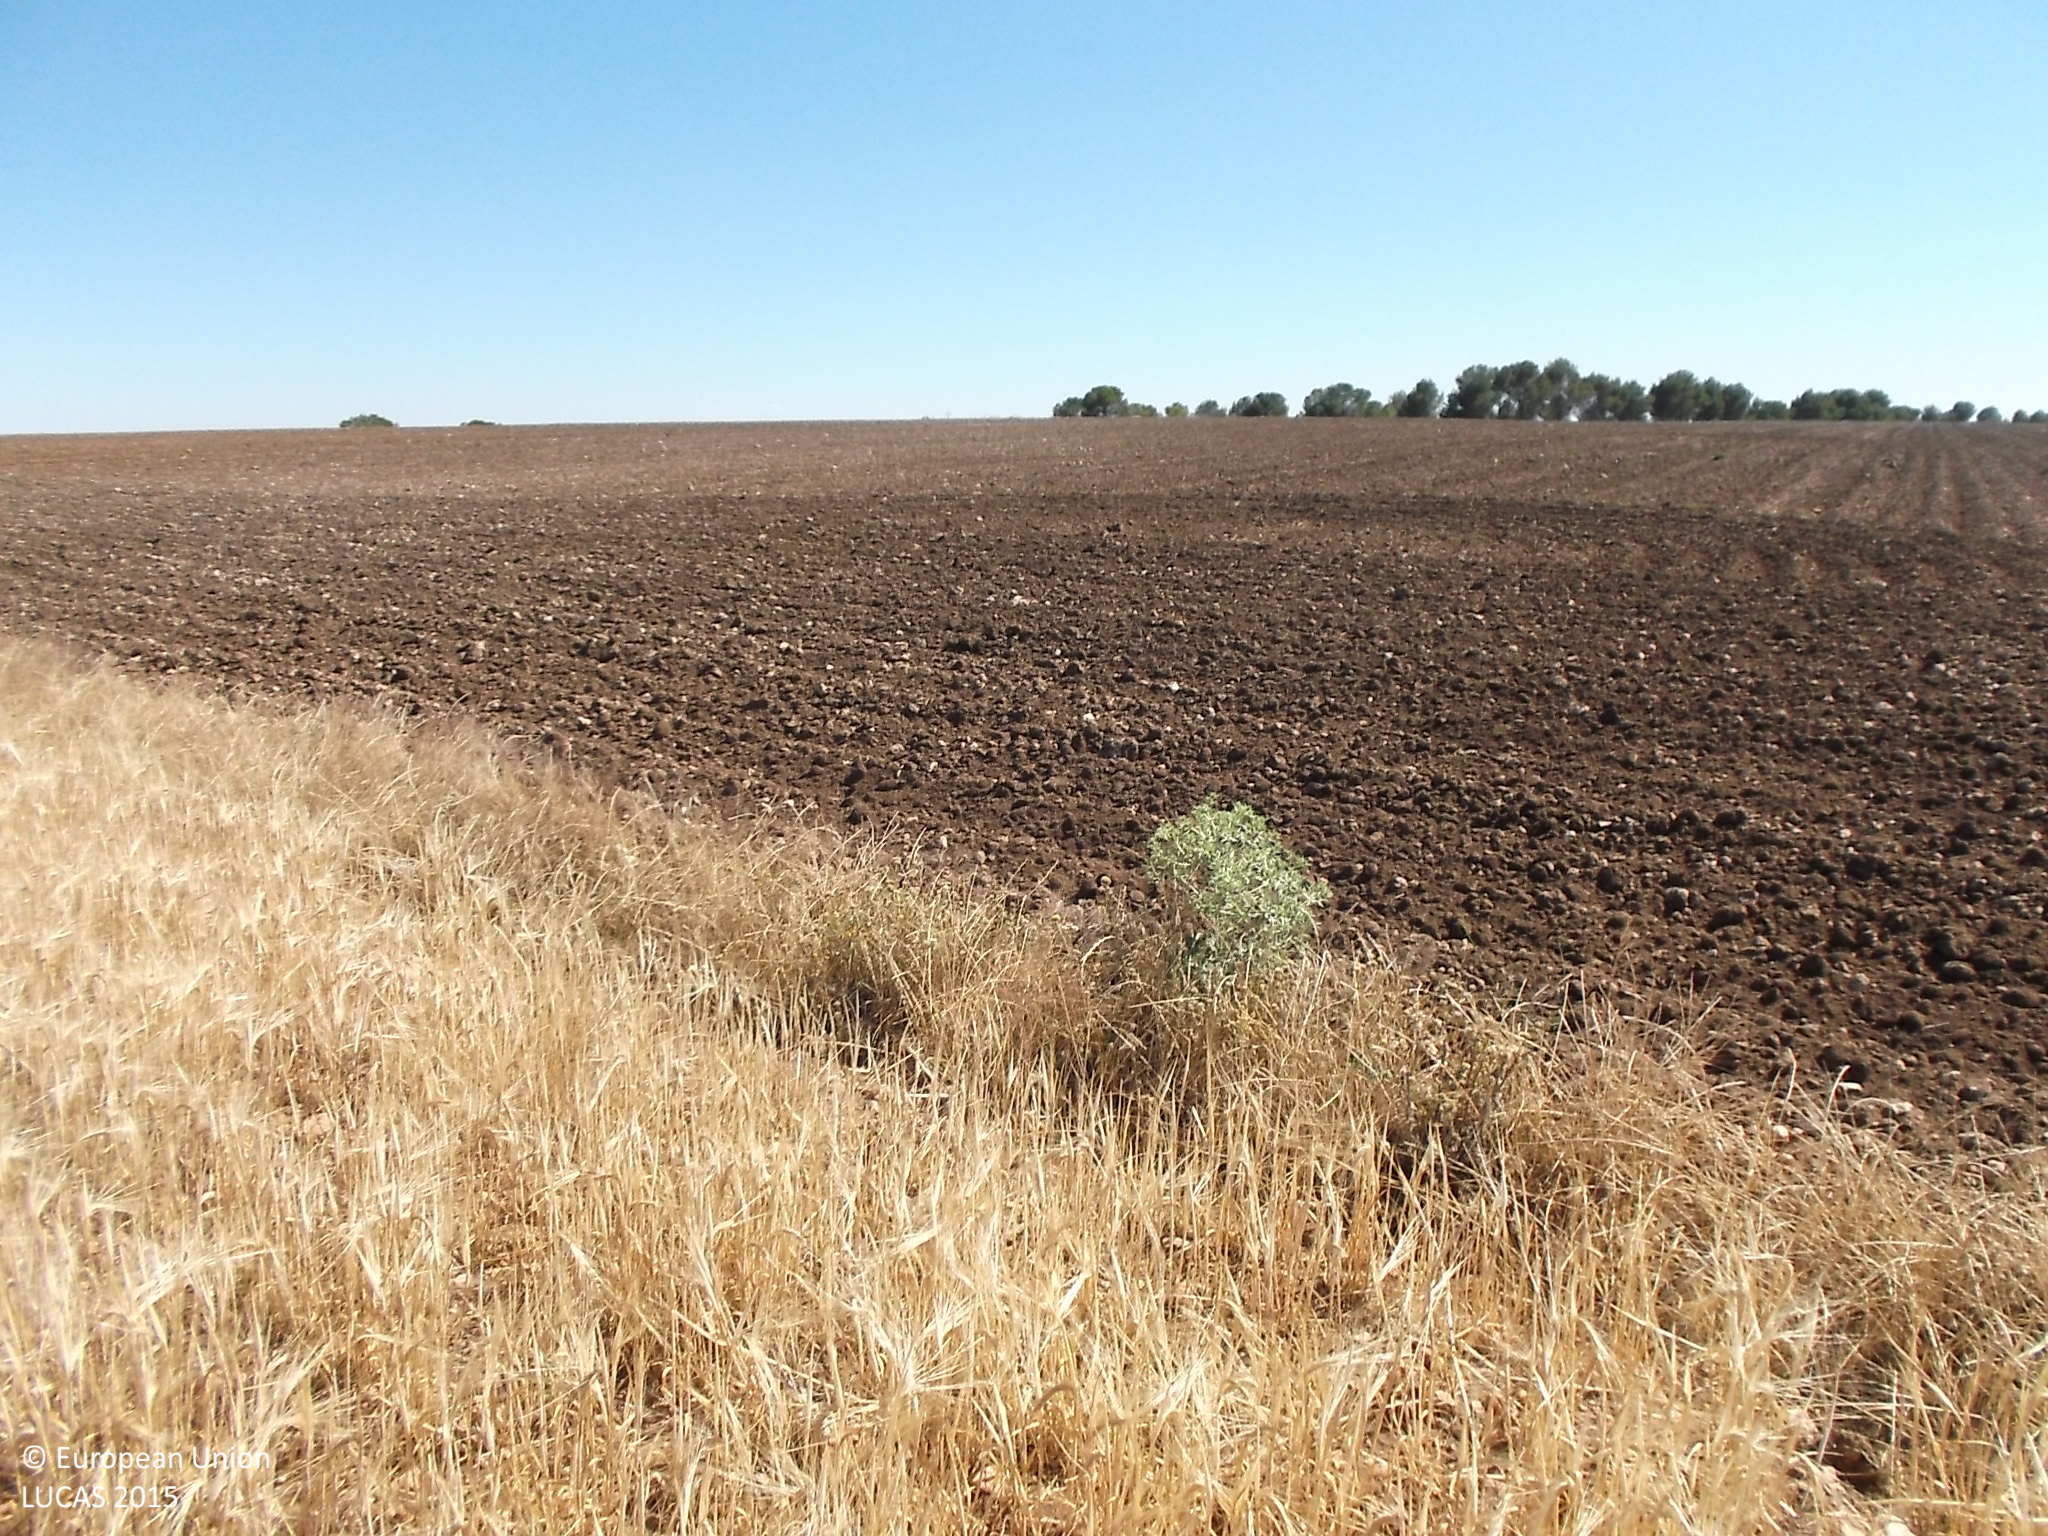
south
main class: Cropland
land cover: Barley
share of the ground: > 75 %
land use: Agriculture (excluding fallow land and kitchen gardens)
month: June
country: ES
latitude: 41.3705
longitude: -5.3197
